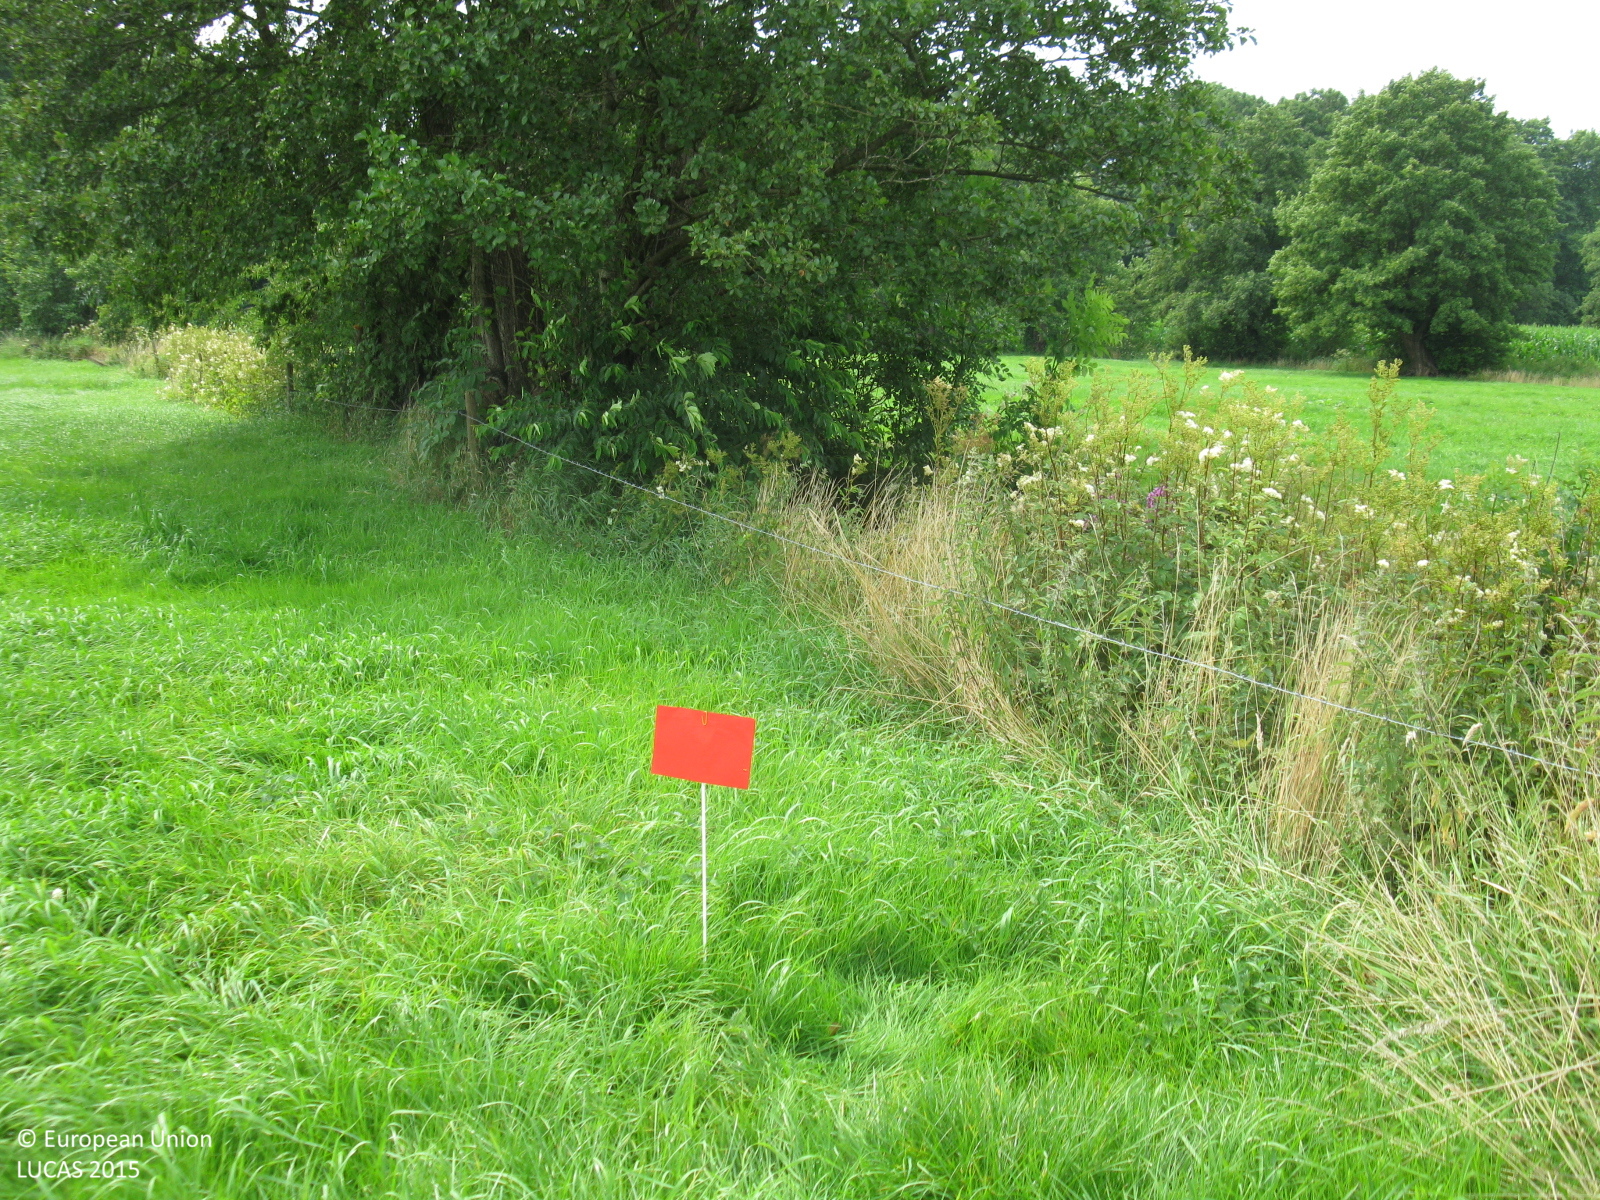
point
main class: Grassland
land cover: Grassland without tree/shrub cover
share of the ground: > 75 %
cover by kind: herbaceous plants 100 %
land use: Agriculture (excluding fallow land and kitchen gardens)
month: August
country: DE
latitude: 53.1389
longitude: 8.3413
